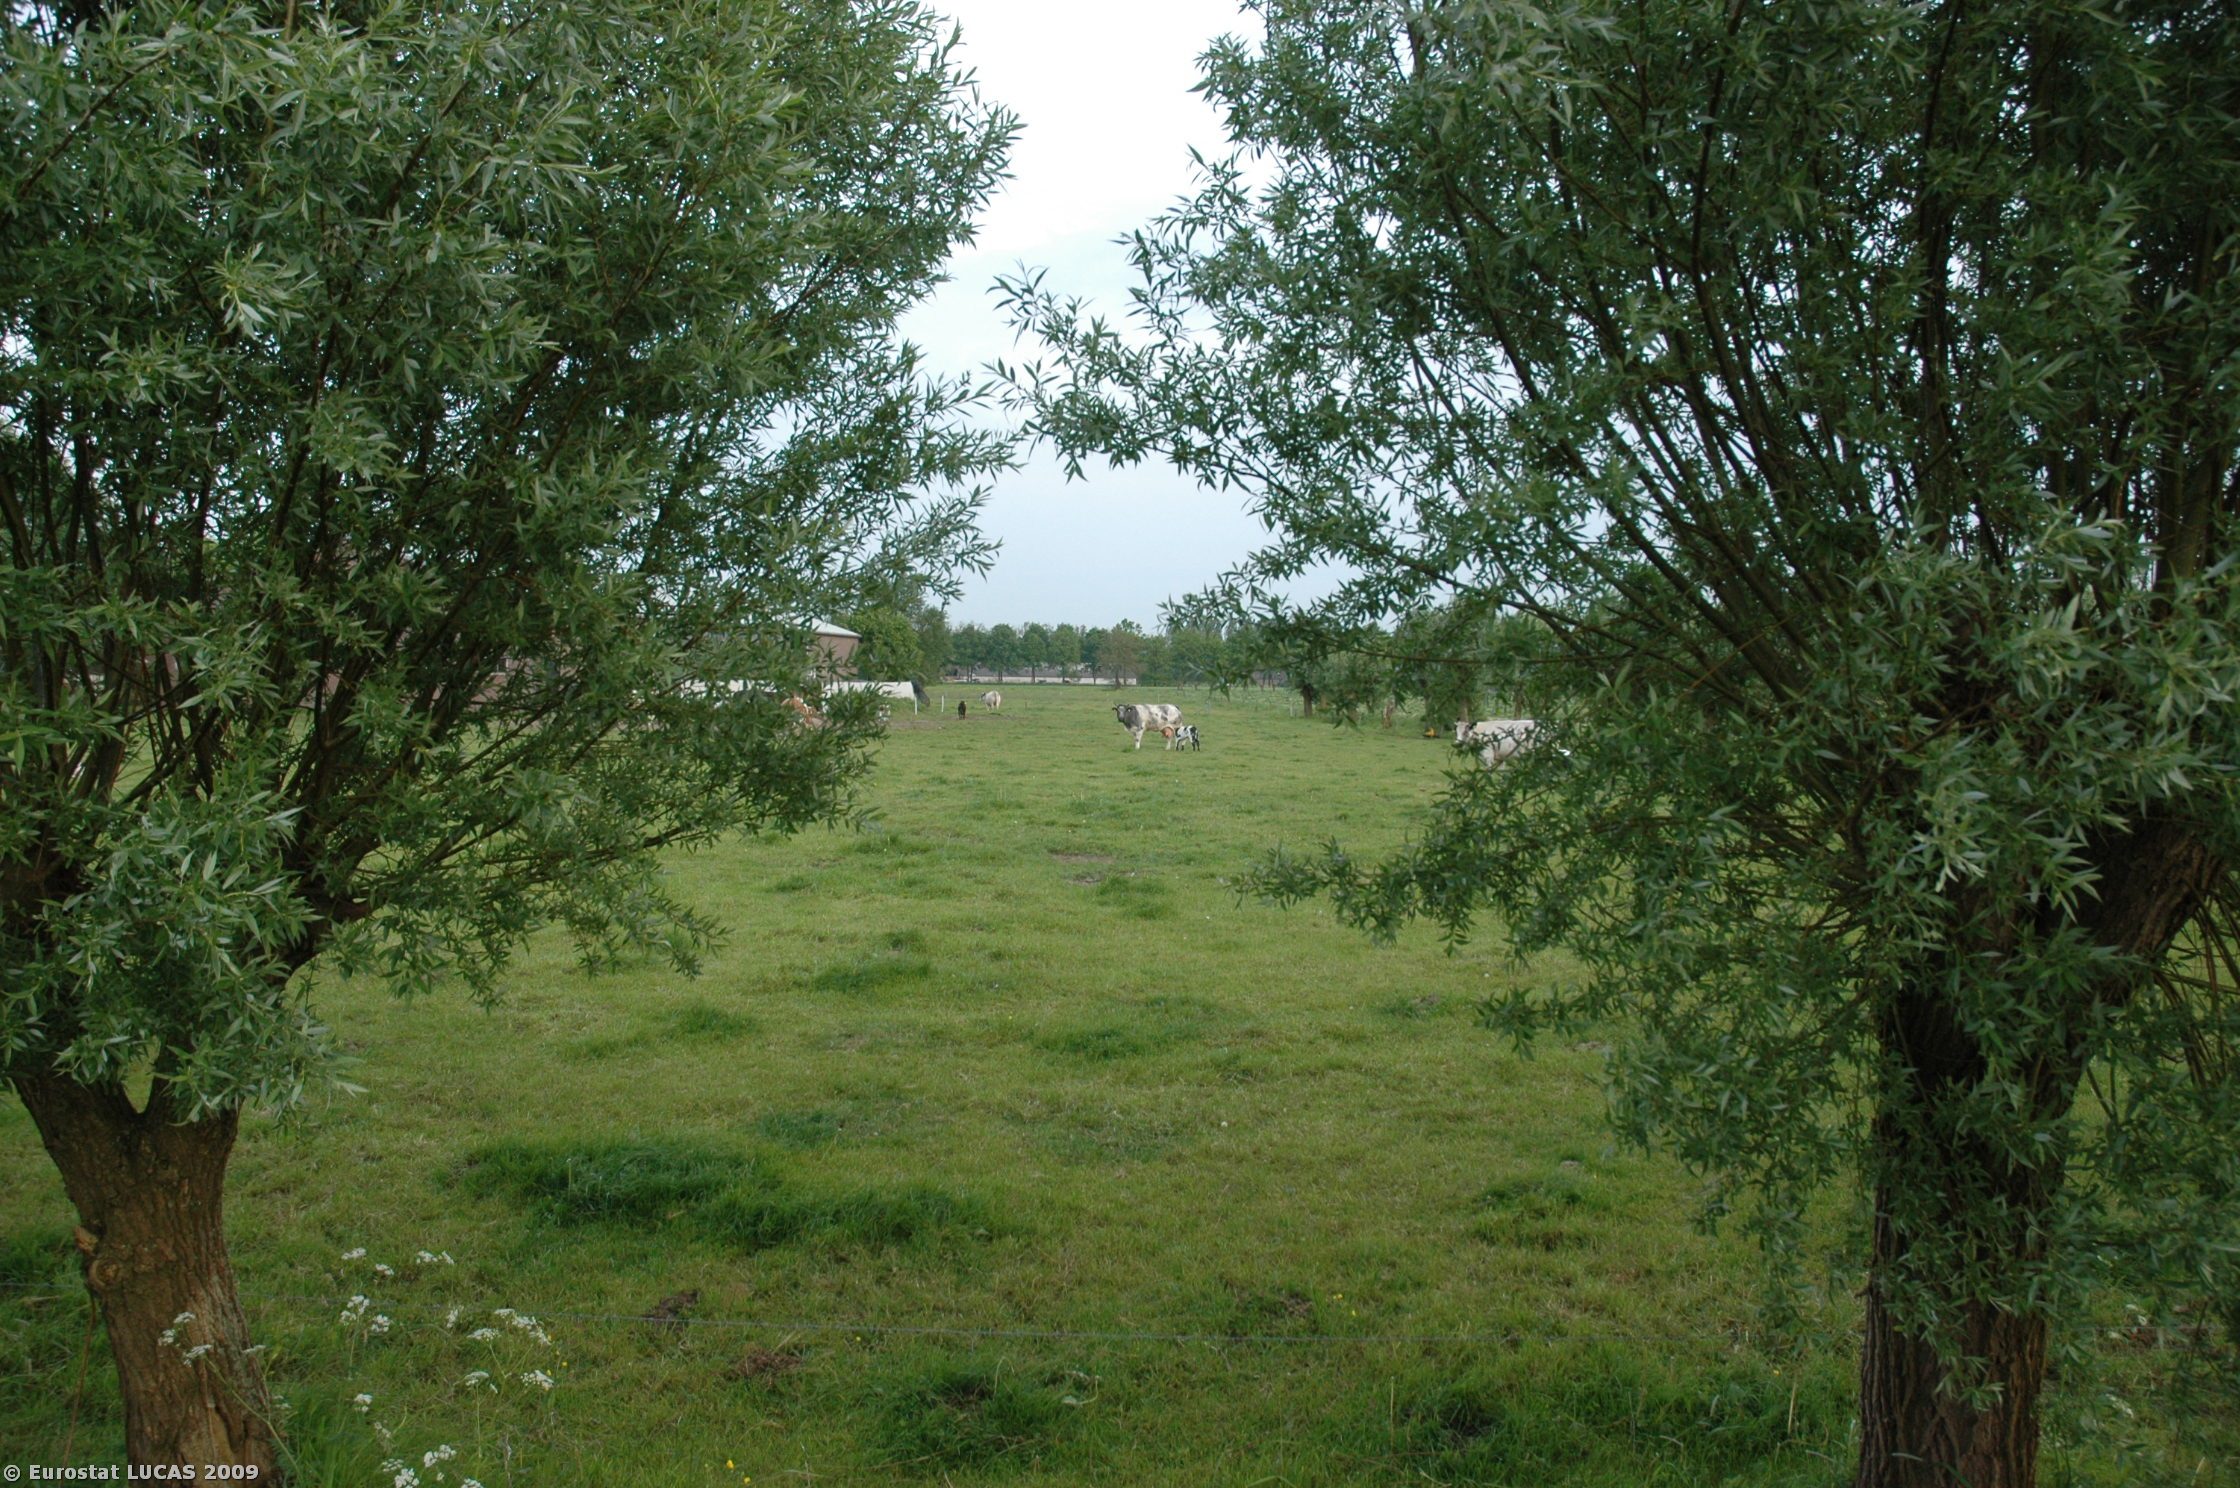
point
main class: Grassland
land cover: Grassland without tree/shrub cover
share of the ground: > 75 %
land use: Agriculture (excluding fallow land and kitchen gardens)
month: May
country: NL
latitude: 52.0724
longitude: 5.4024
